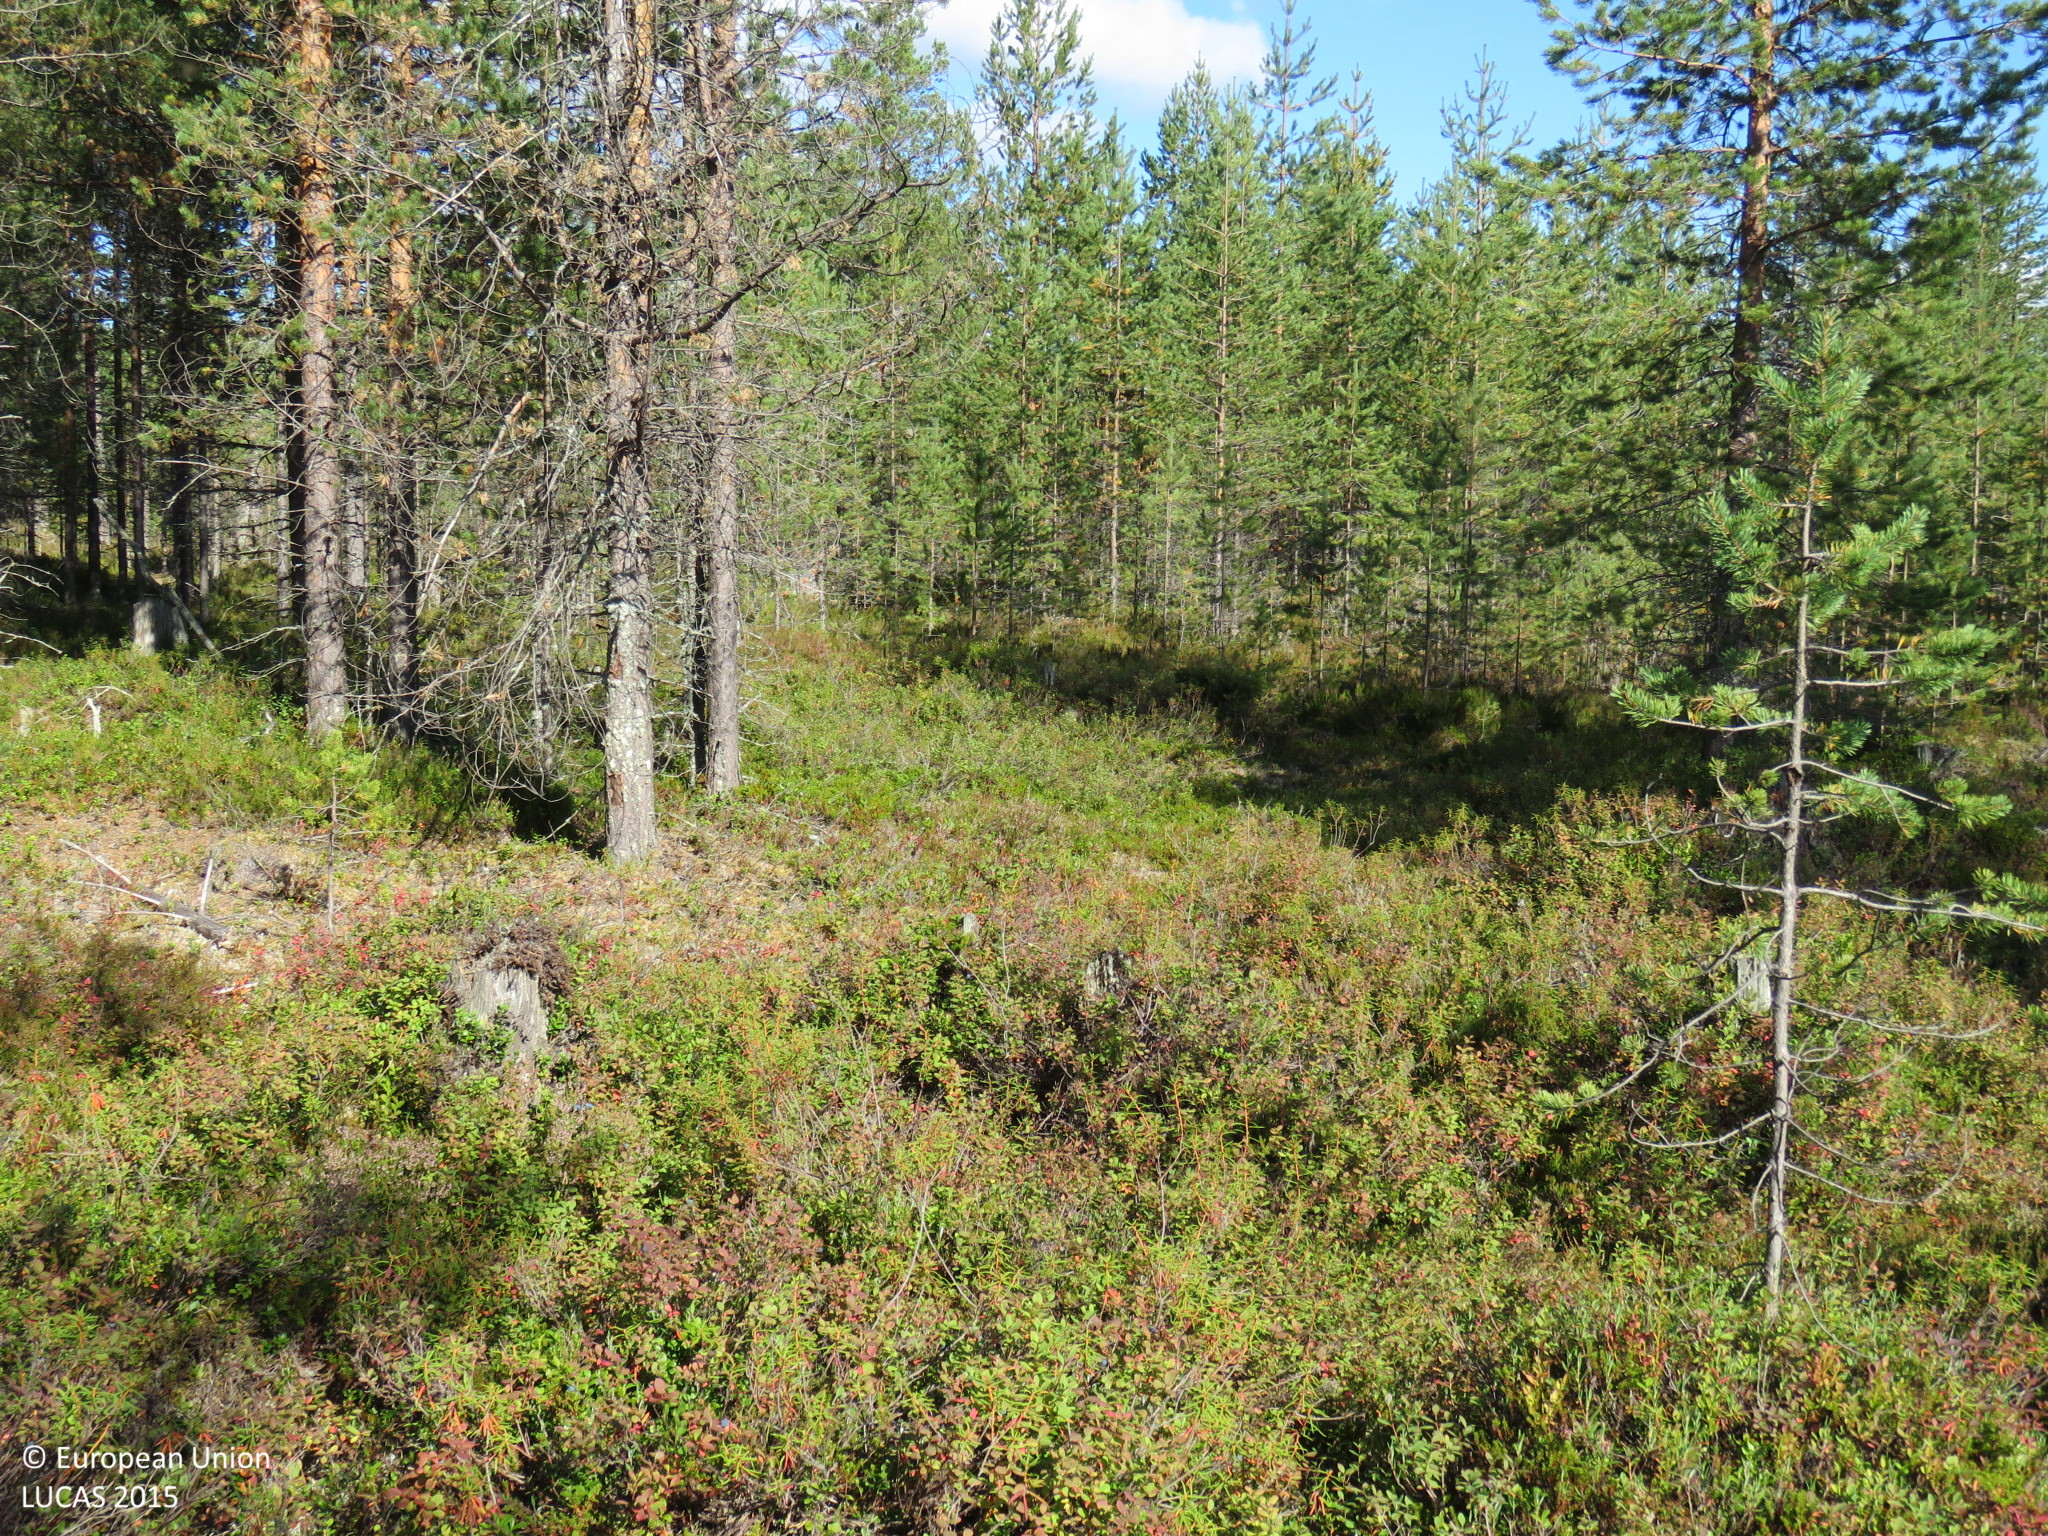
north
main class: Woodland
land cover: Pine dominated coniferous woodland
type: boreal forest
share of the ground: > 75 %
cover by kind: coniferous forest trees 80 %, shrubs 15 %, lichens and mosses 5 %
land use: Forestry
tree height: > 5 m
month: September
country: FI
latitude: 65.3921
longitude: 27.4551
